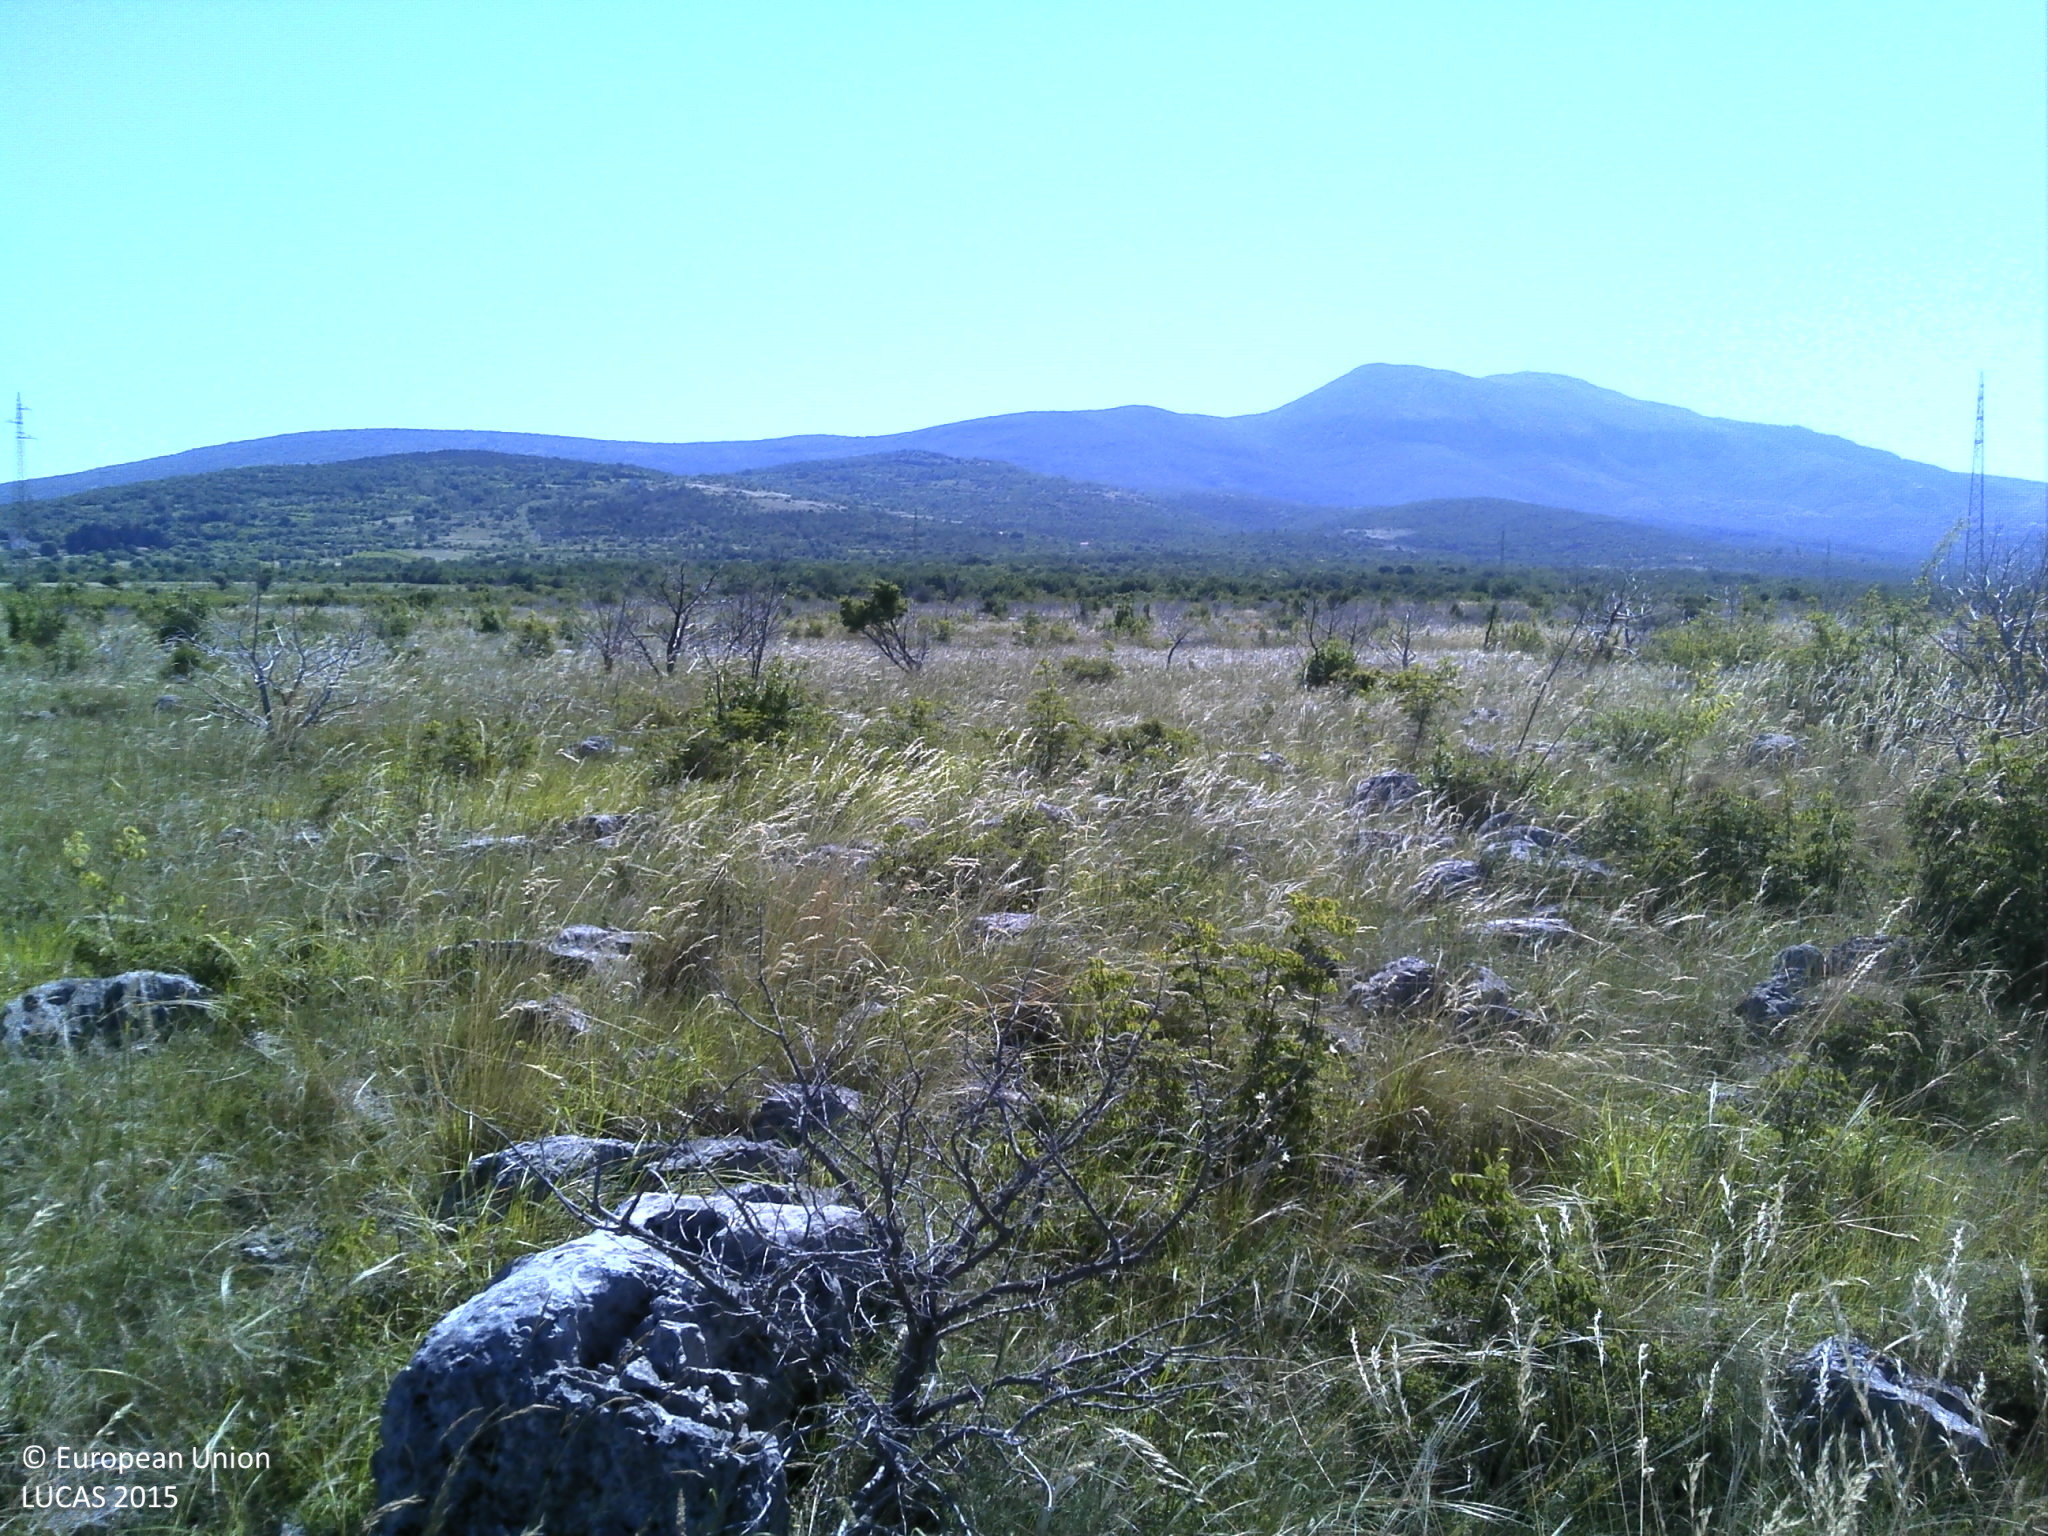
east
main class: Grassland
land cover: Grassland without tree/shrub cover
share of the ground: > 75 %
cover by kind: herbaceous plants 85 %, unconsolidated bare surface 10 %, shrubs 5 %
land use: Semi-natural and natural areas not in use
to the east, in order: Grassland without tree/shrub cover
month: May
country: HR
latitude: 43.9549
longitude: 16.0857
